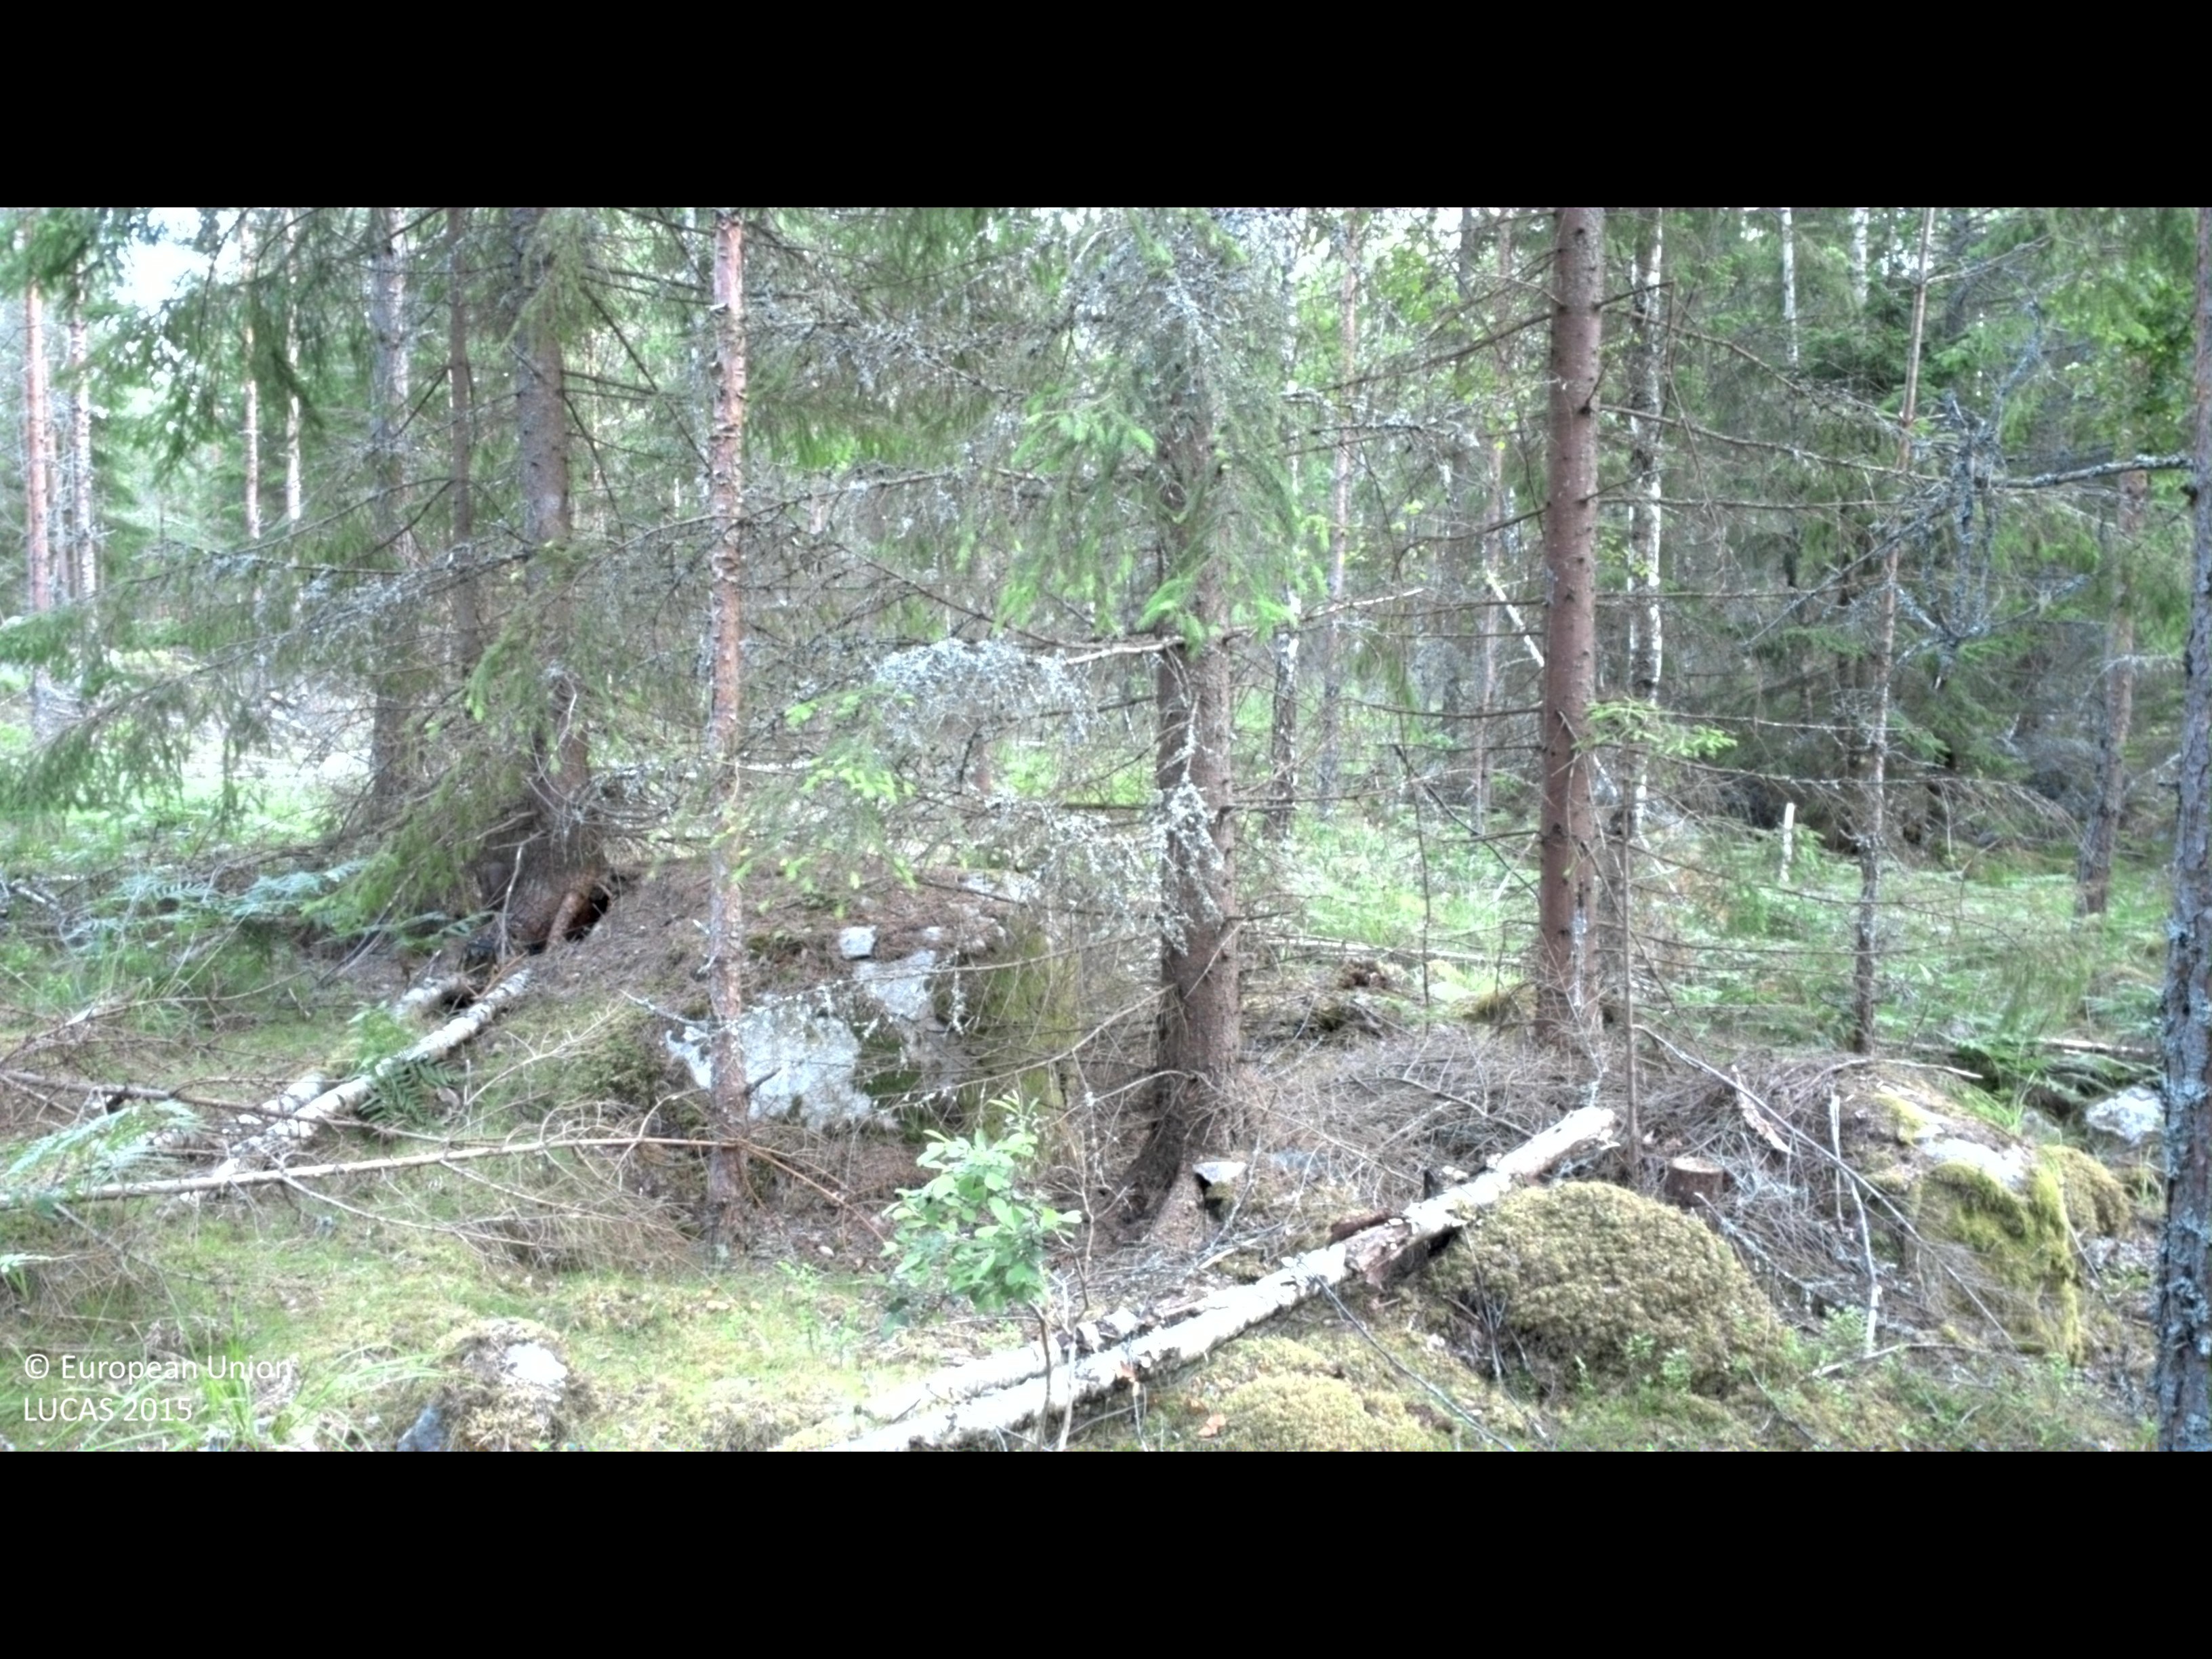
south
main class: Woodland
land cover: Pine dominated mixed woodland
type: boreal forest
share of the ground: 50 - 75 %
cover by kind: coniferous forest trees 45 %, broadleaved forest trees 20 %, herbaceous plants 15 %, shrubs 10 %, lichens and mosses 10 %
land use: Forestry
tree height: > 5 m
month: June
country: SE
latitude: 58.2562
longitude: 16.2162
